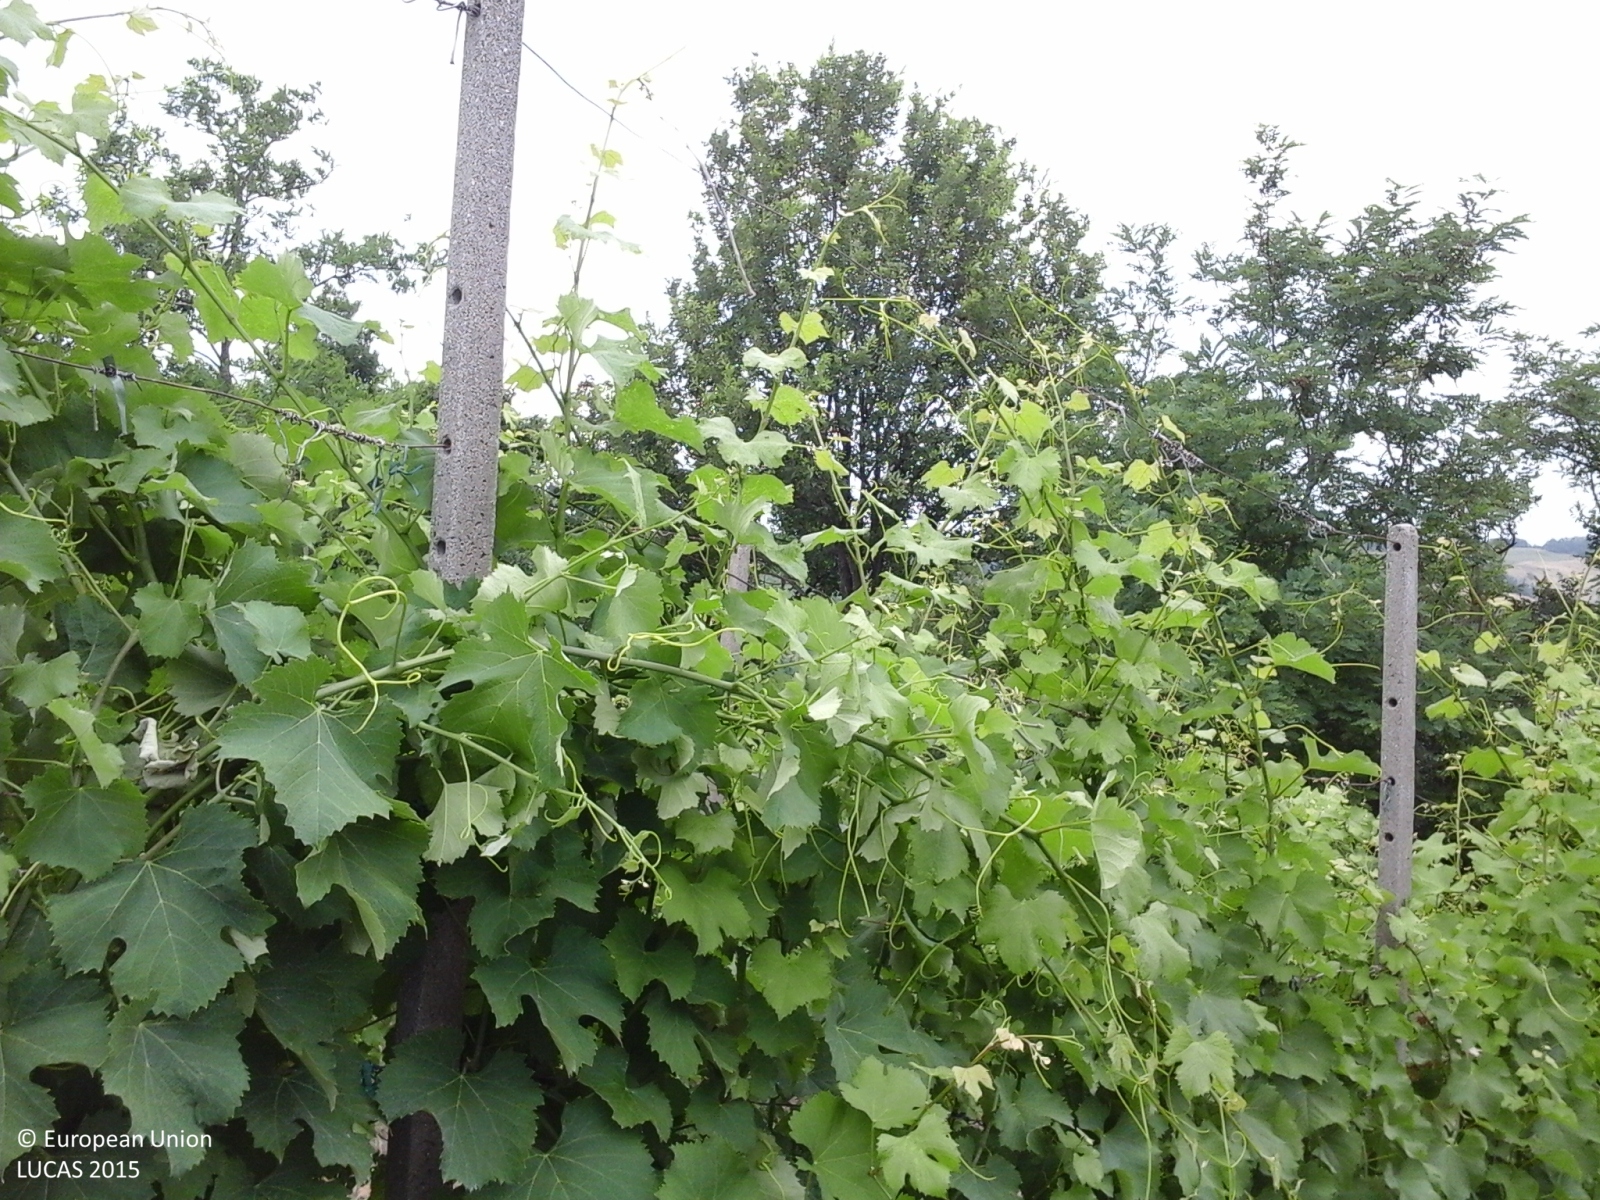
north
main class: Cropland
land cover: Vineyards
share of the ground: < 10 %
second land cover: Other bare soil
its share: > 75 %
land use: Agriculture (excluding fallow land and kitchen gardens)
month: June
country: IT
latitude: 44.8374
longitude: 9.8864
